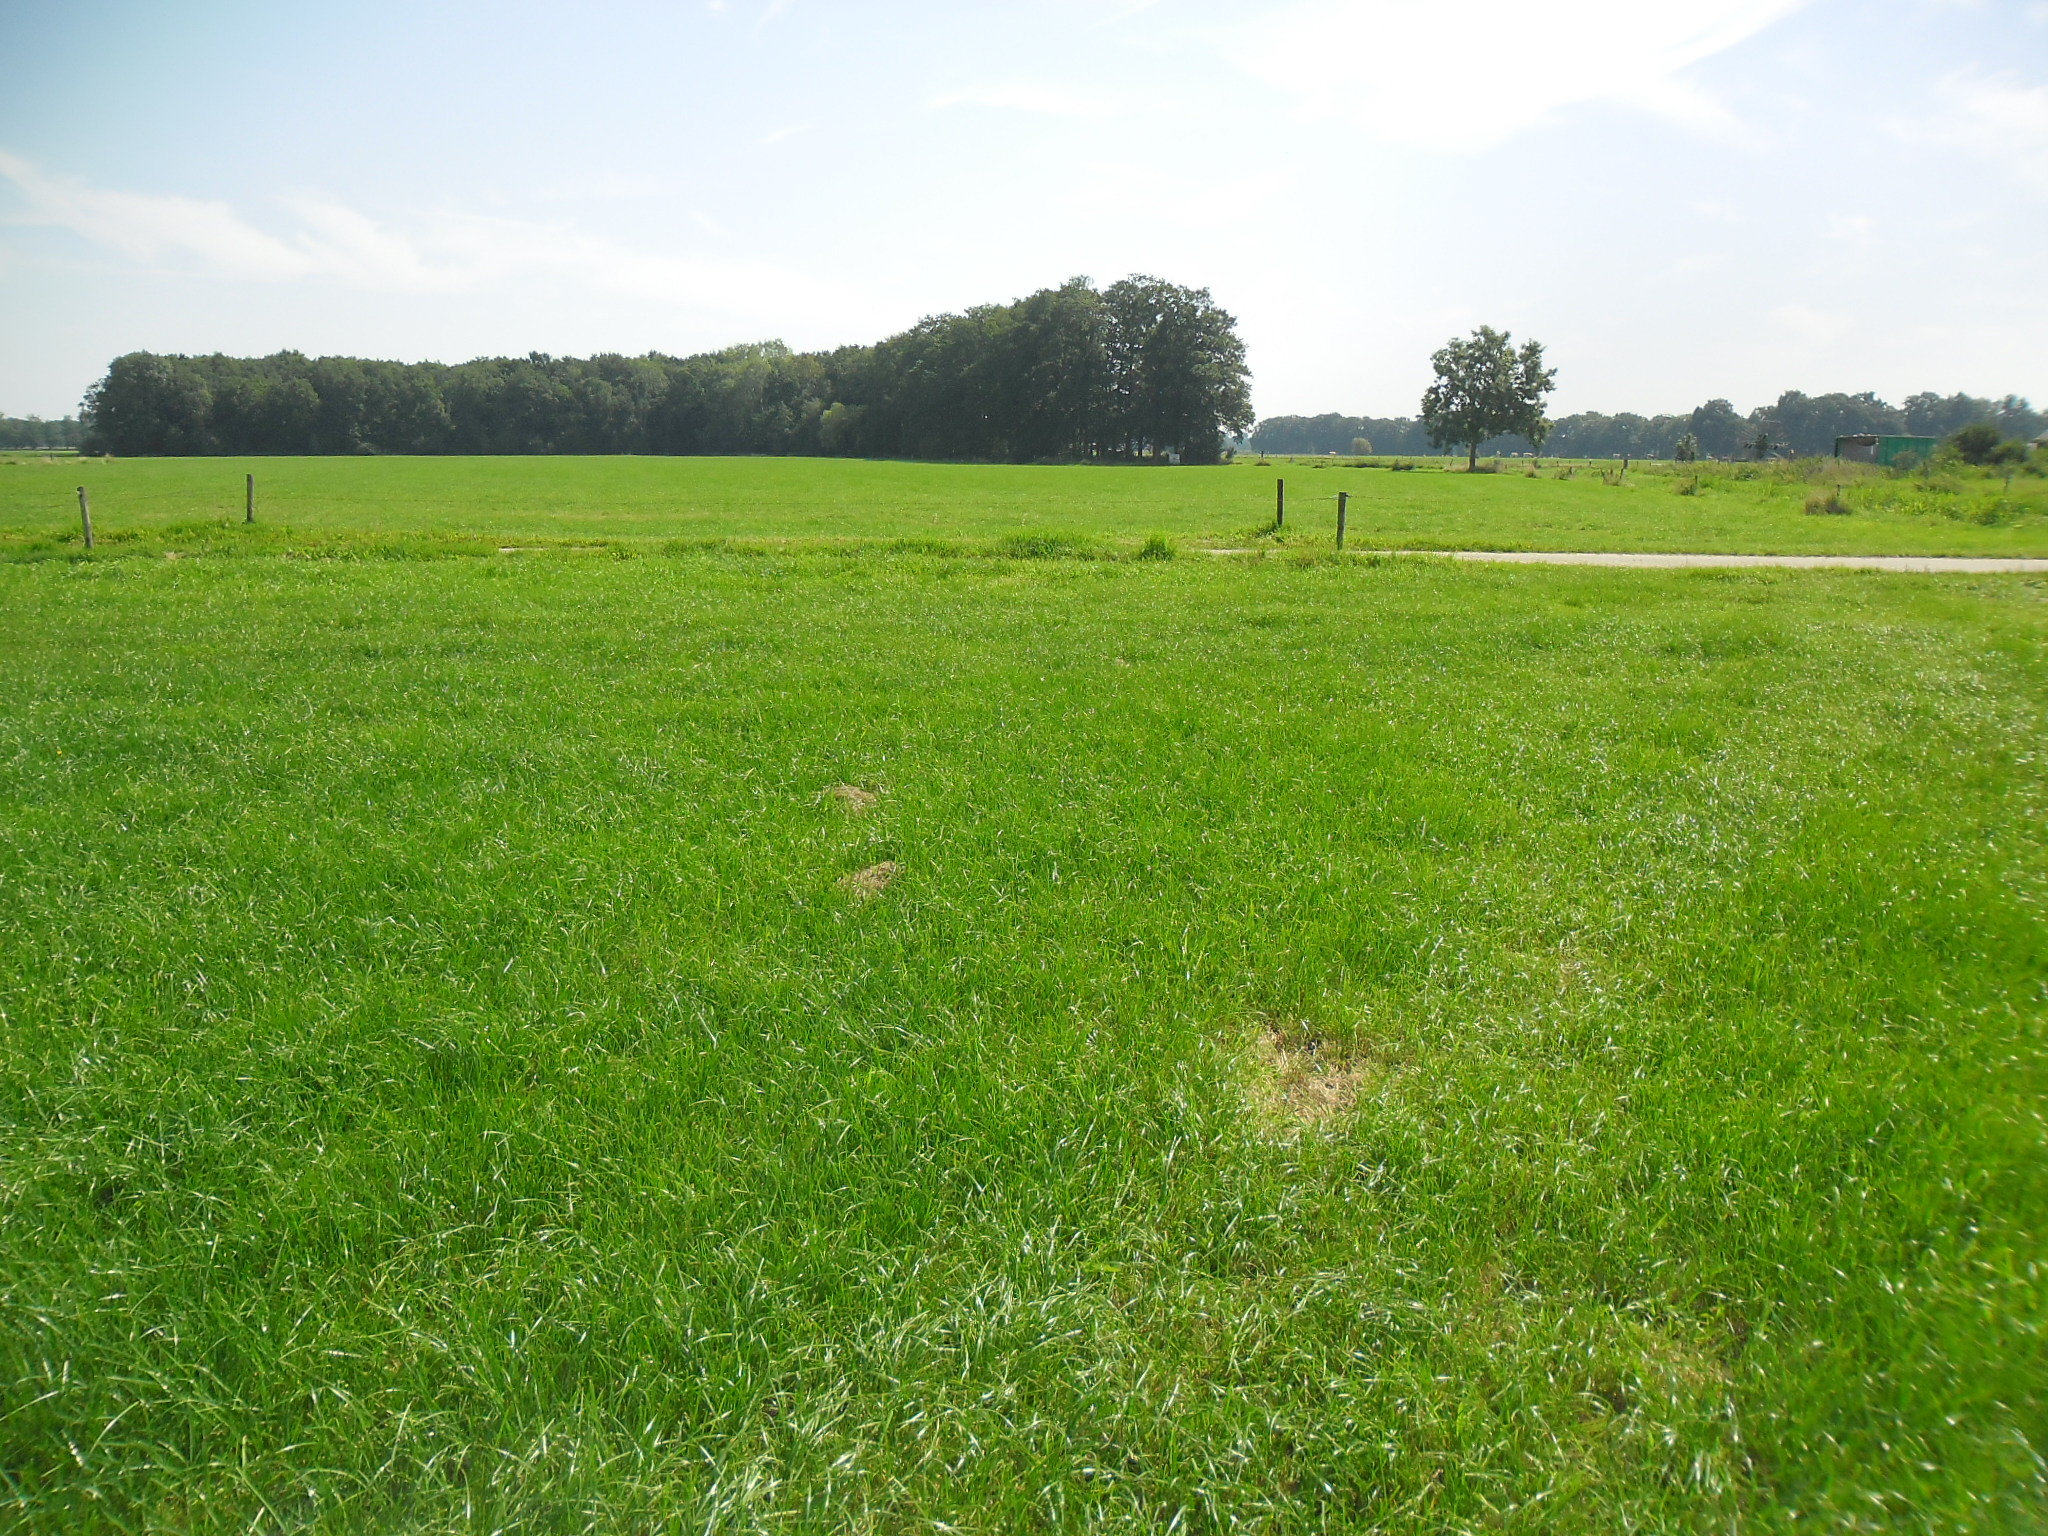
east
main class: Grassland
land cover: Grassland without tree/shrub cover
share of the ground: > 75 %
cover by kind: herbaceous plants 100 %
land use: Agriculture (excluding fallow land and kitchen gardens)
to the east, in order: Grassland without tree/shrub cover; Fences; Paved roads, cycling and walking lanes; Fences; Grassland without tree/shrub cover
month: August
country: NL
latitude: 52.4064
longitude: 6.1923
